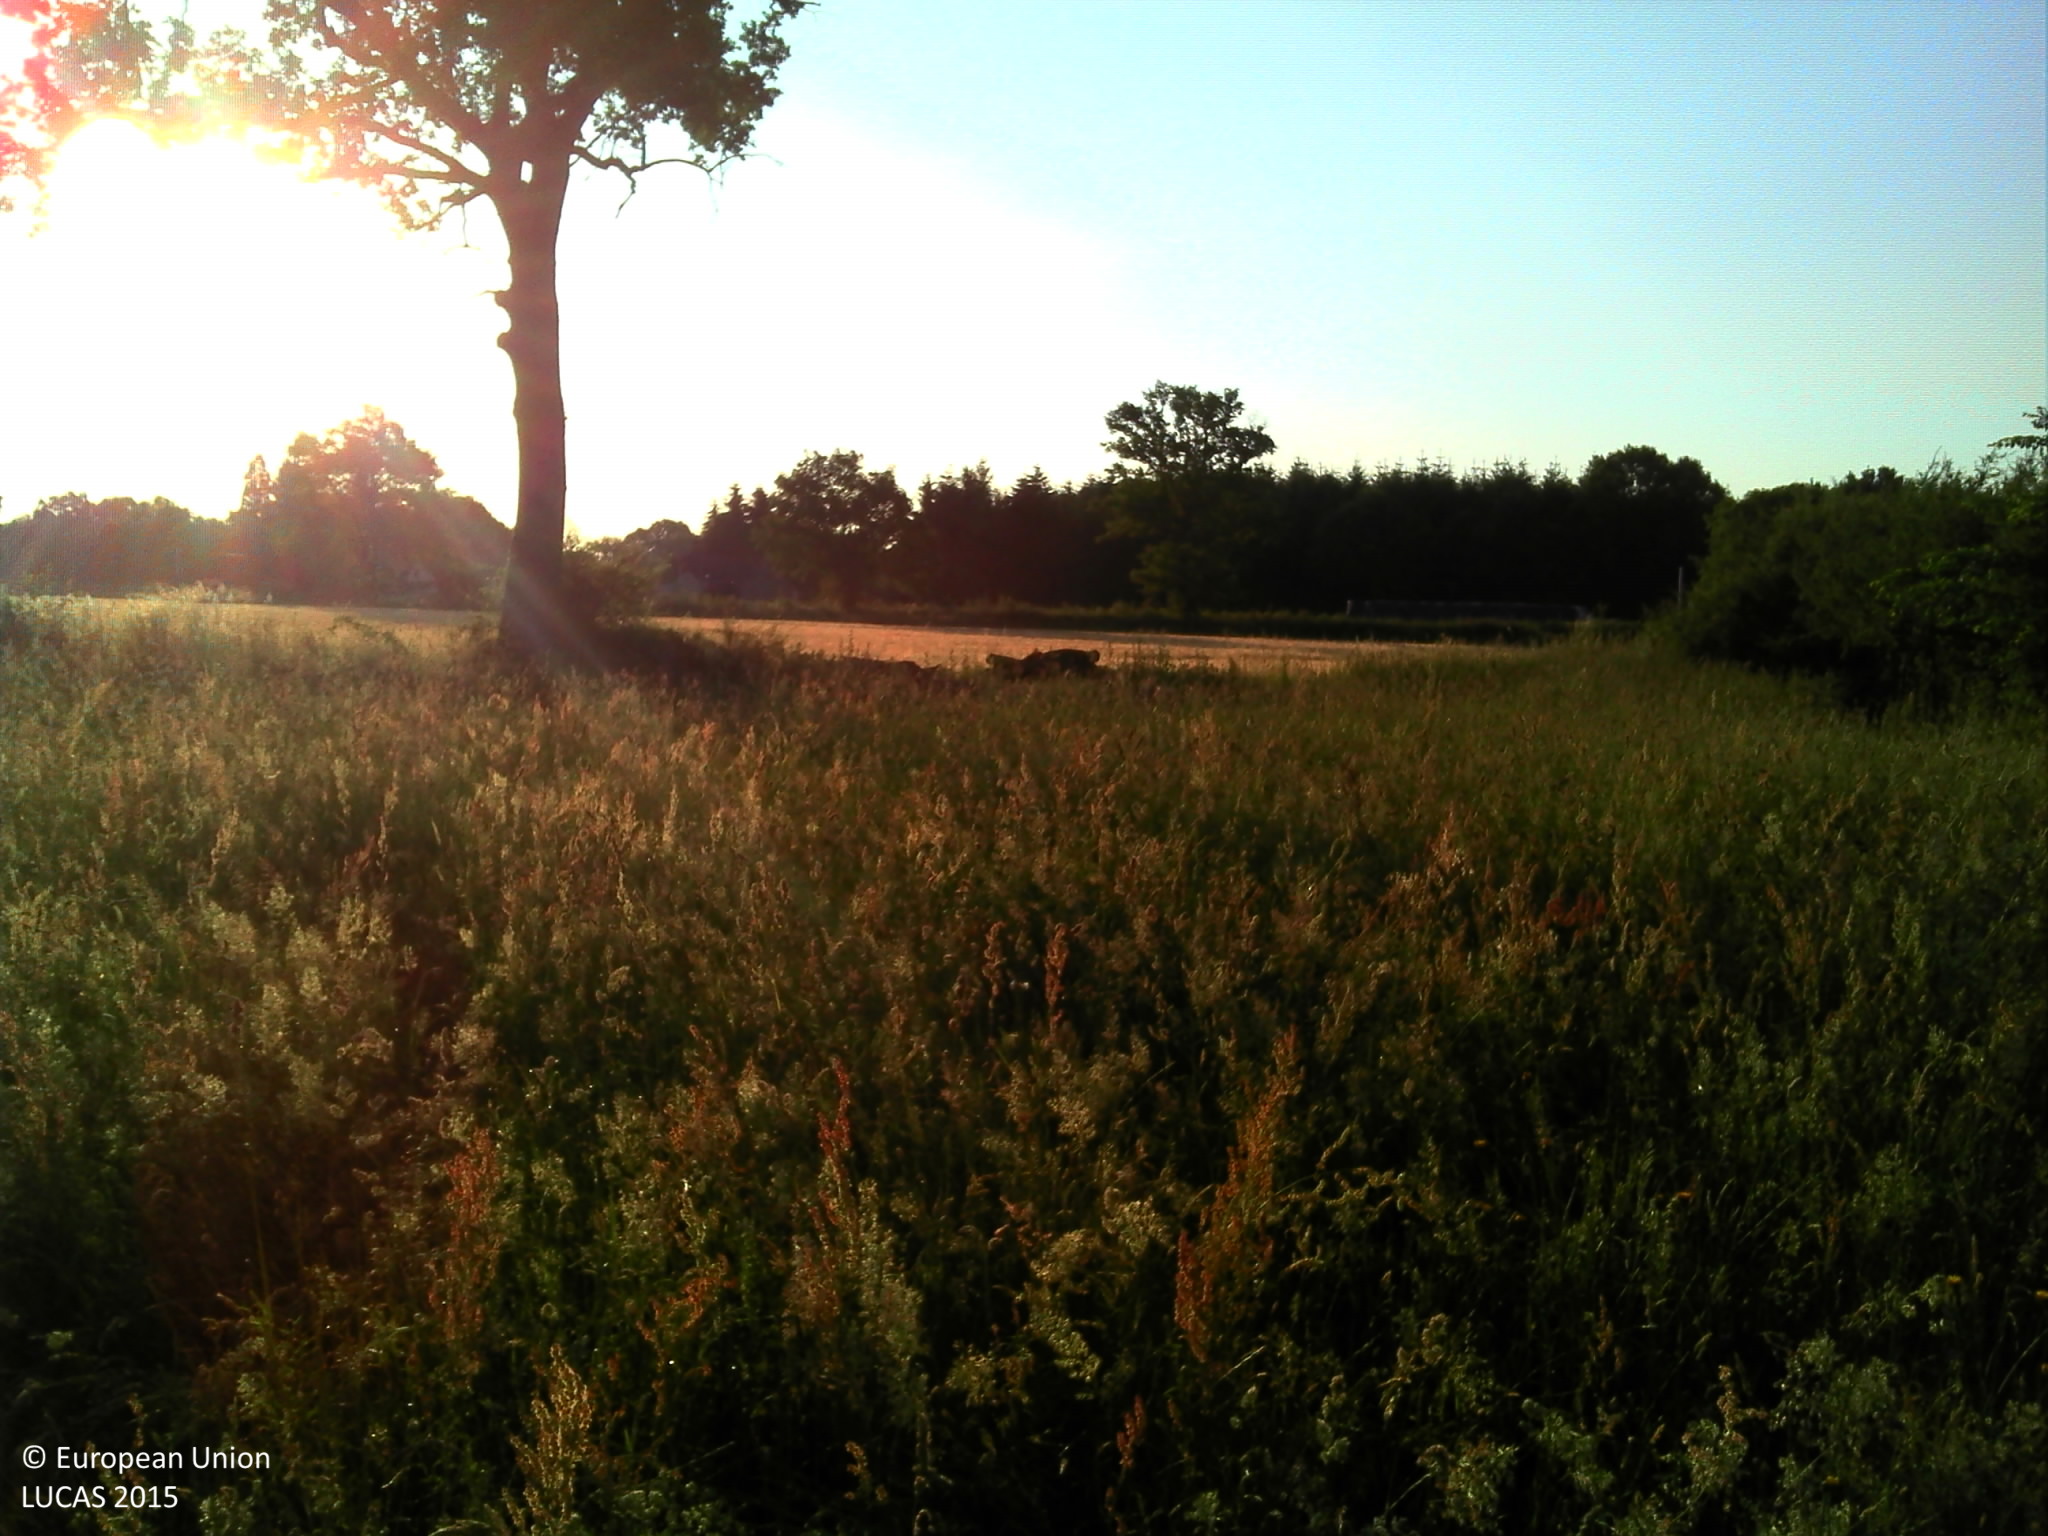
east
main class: Grassland
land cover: Grassland without tree/shrub cover
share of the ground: > 75 %
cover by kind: herbaceous plants 100 %
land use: Agriculture (excluding fallow land and kitchen gardens)
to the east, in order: Grassland without tree/shrub cover; Fences; Single bushes/trees; Barley; Abandoned hedges; Grass margins; Paved roads, cycling and walking lanes; Grass margins; Ditches and canals; Abandoned hedges; Electric lines; Grassland without tree/shrub cover; Fences; Broadleaved woodland; Spruce dominated coniferous woodland
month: June
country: FR
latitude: 46.8042
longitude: 2.9332
